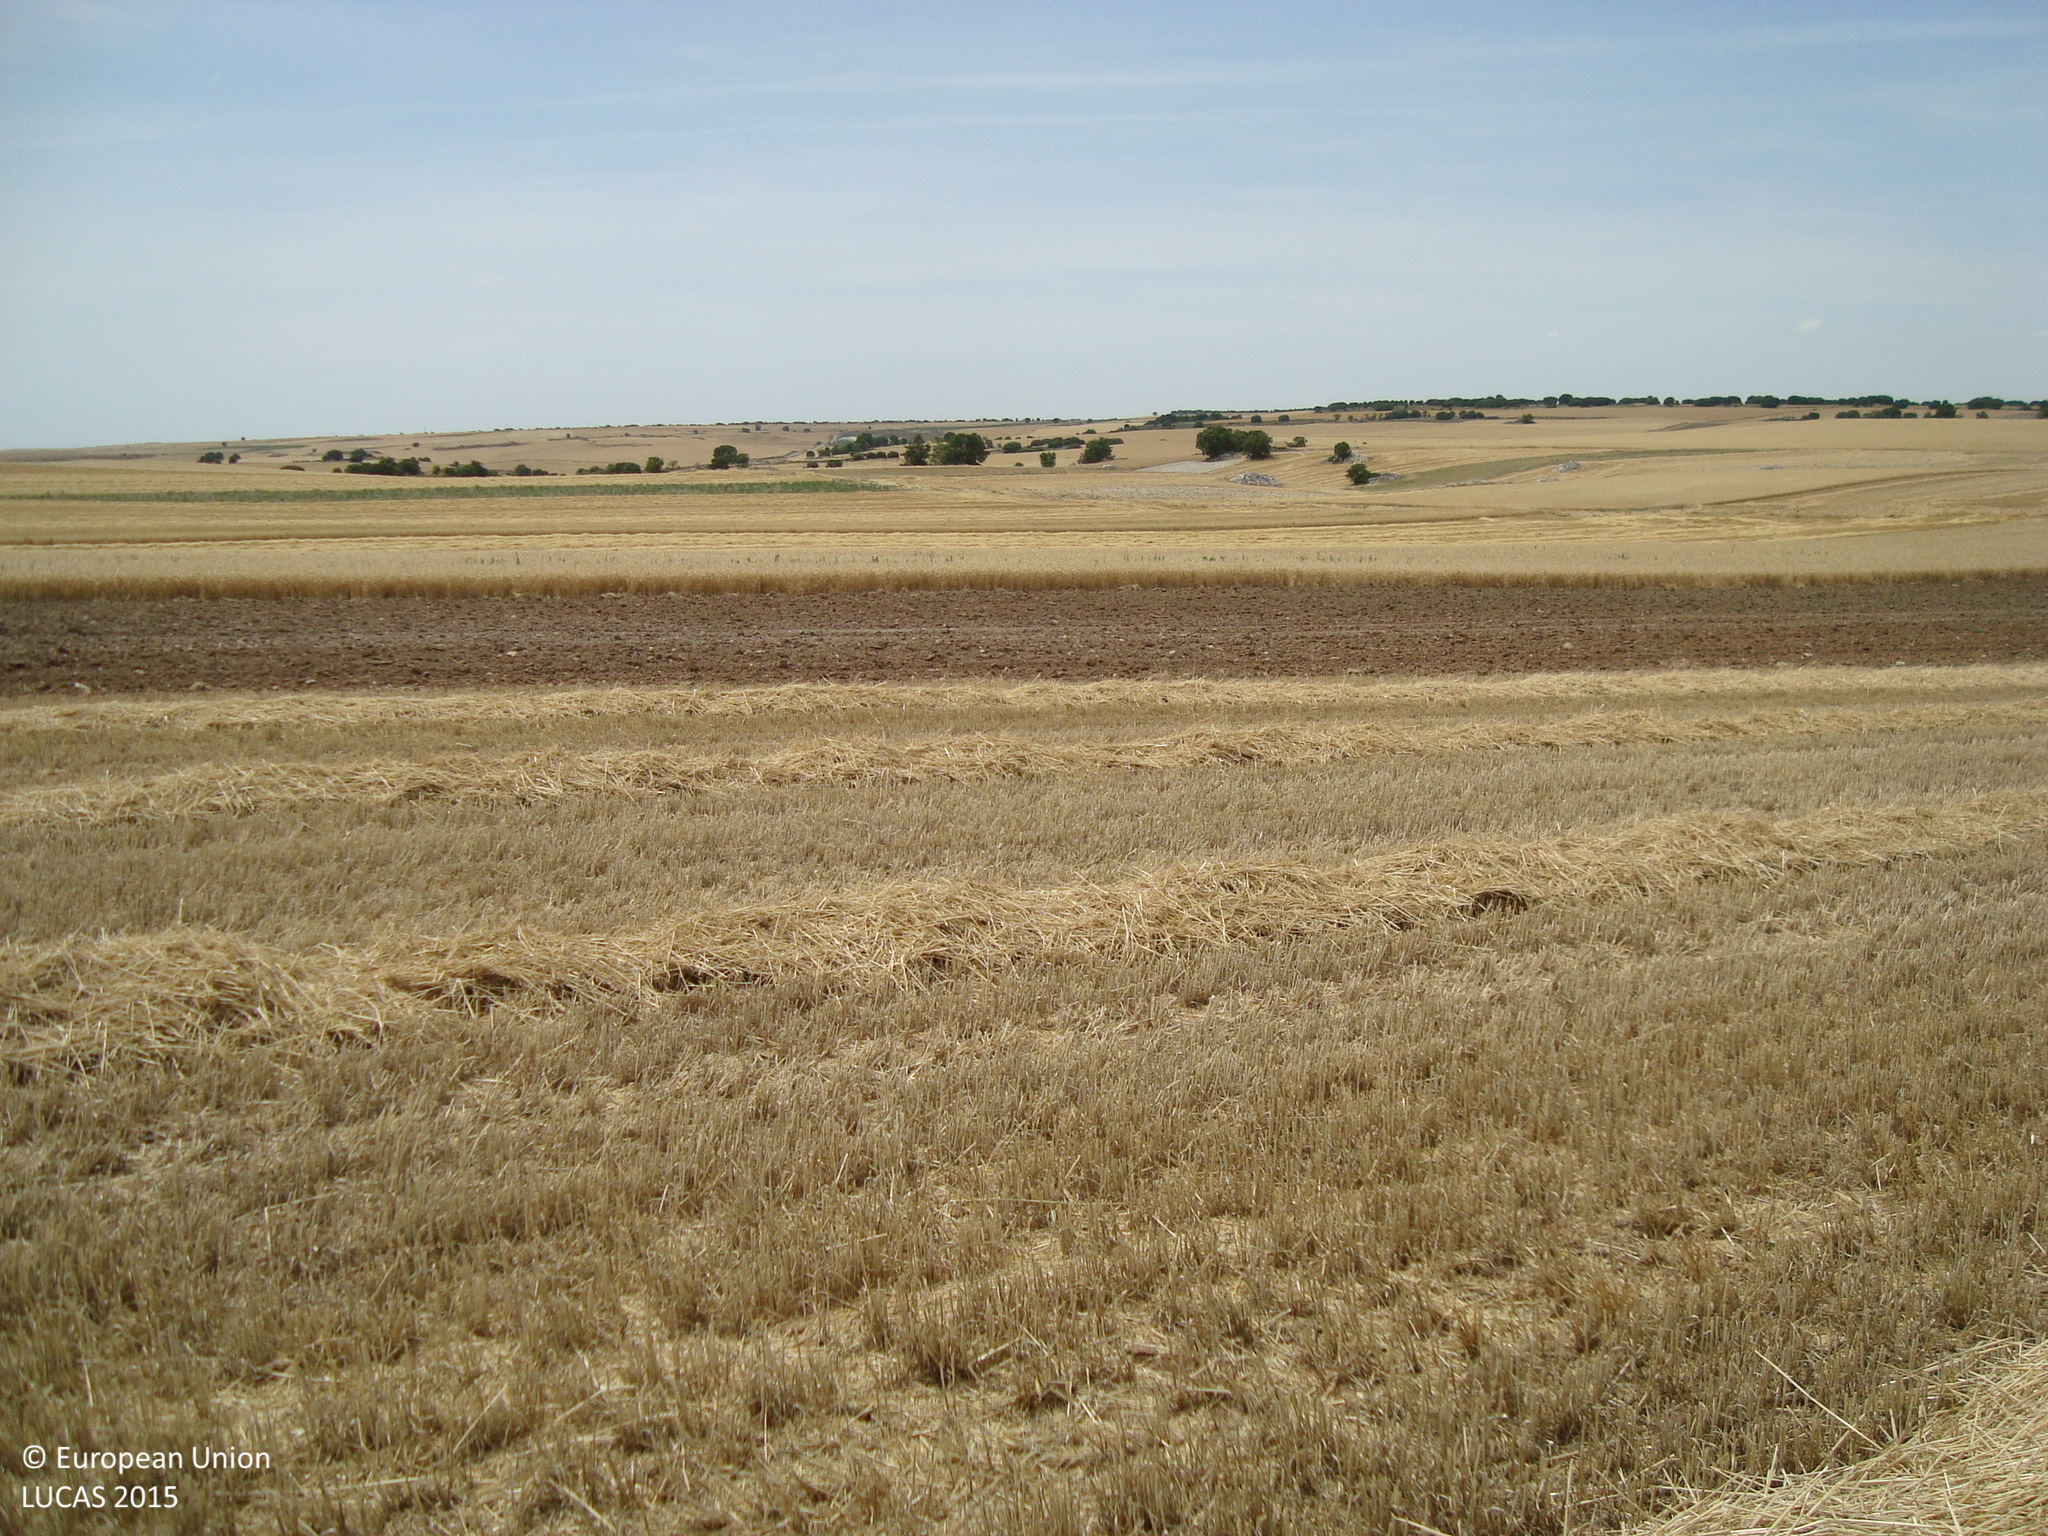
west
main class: Cropland
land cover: Common wheat
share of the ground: < 10 %
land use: Agriculture (excluding fallow land and kitchen gardens)
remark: Harvested field
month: July
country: ES
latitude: 41.7898
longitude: -4.1033
